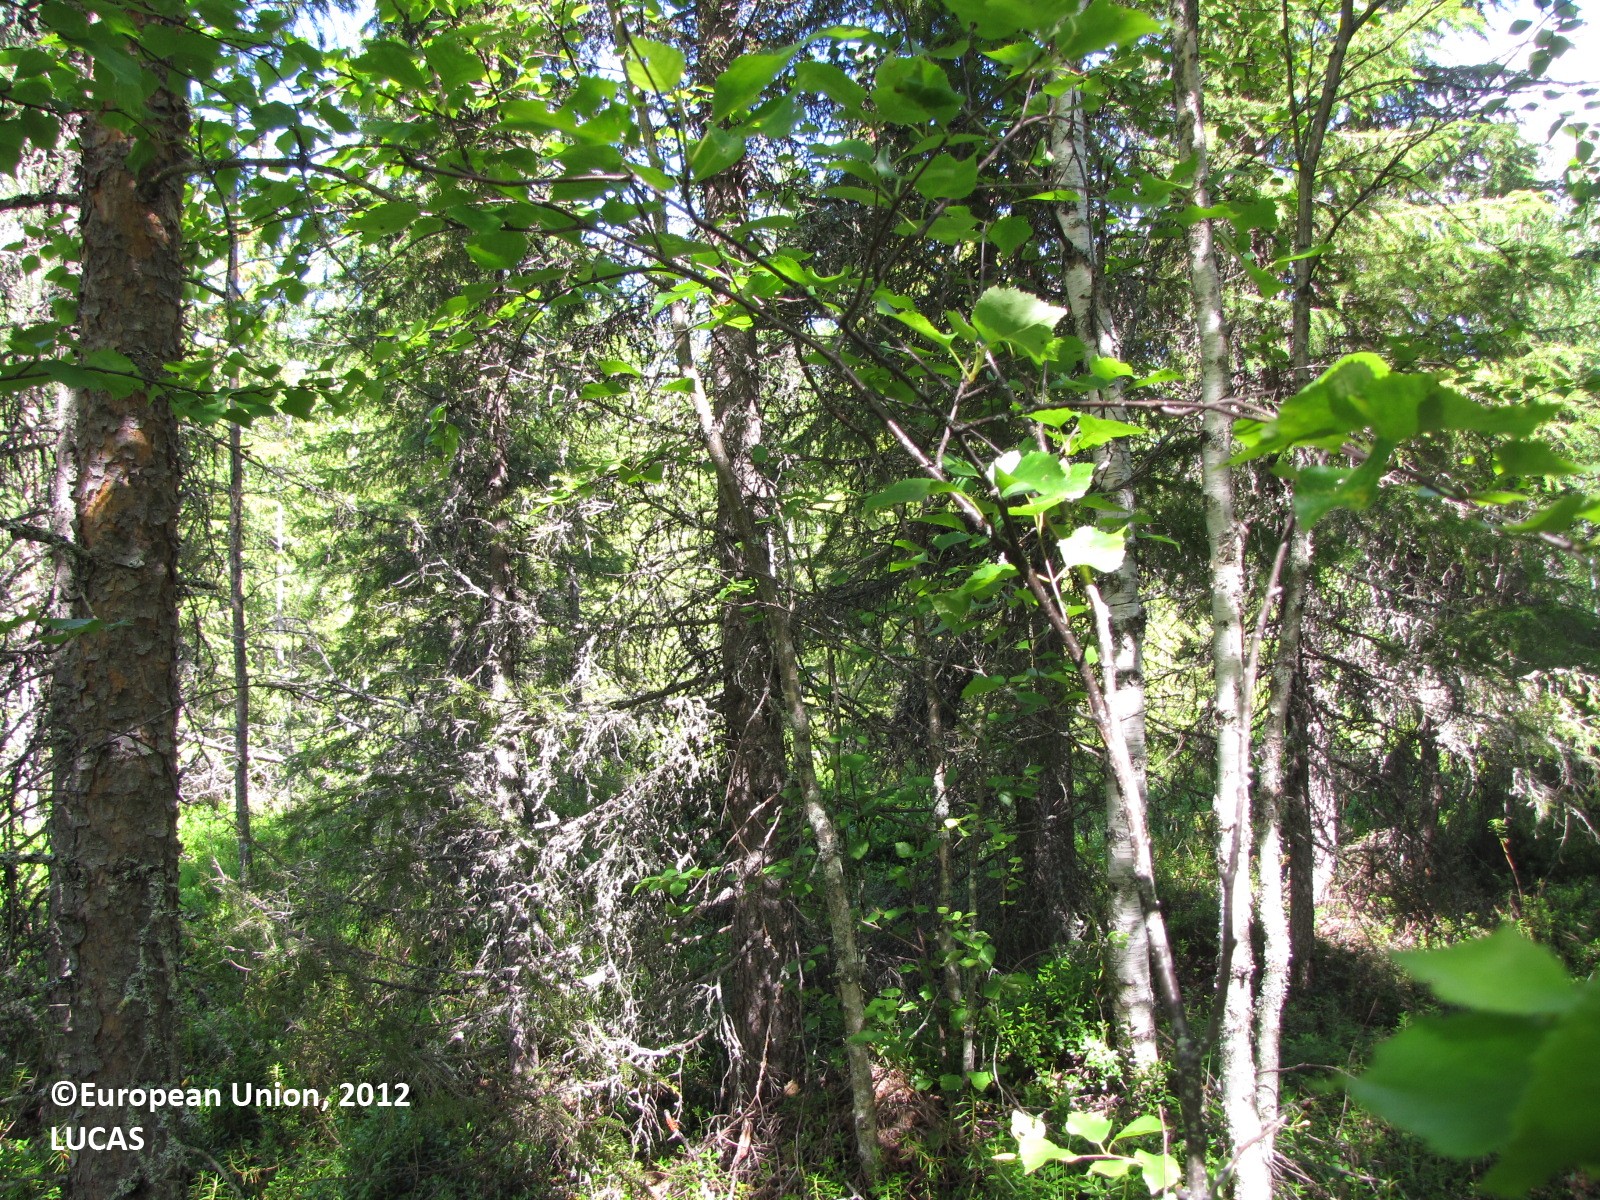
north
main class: Woodland
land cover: Other mixed woodland
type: boreal forest
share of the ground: 50 - 75 %
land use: Forestry
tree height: > 5 m
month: July
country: FI
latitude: 66.5806
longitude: 24.5878
